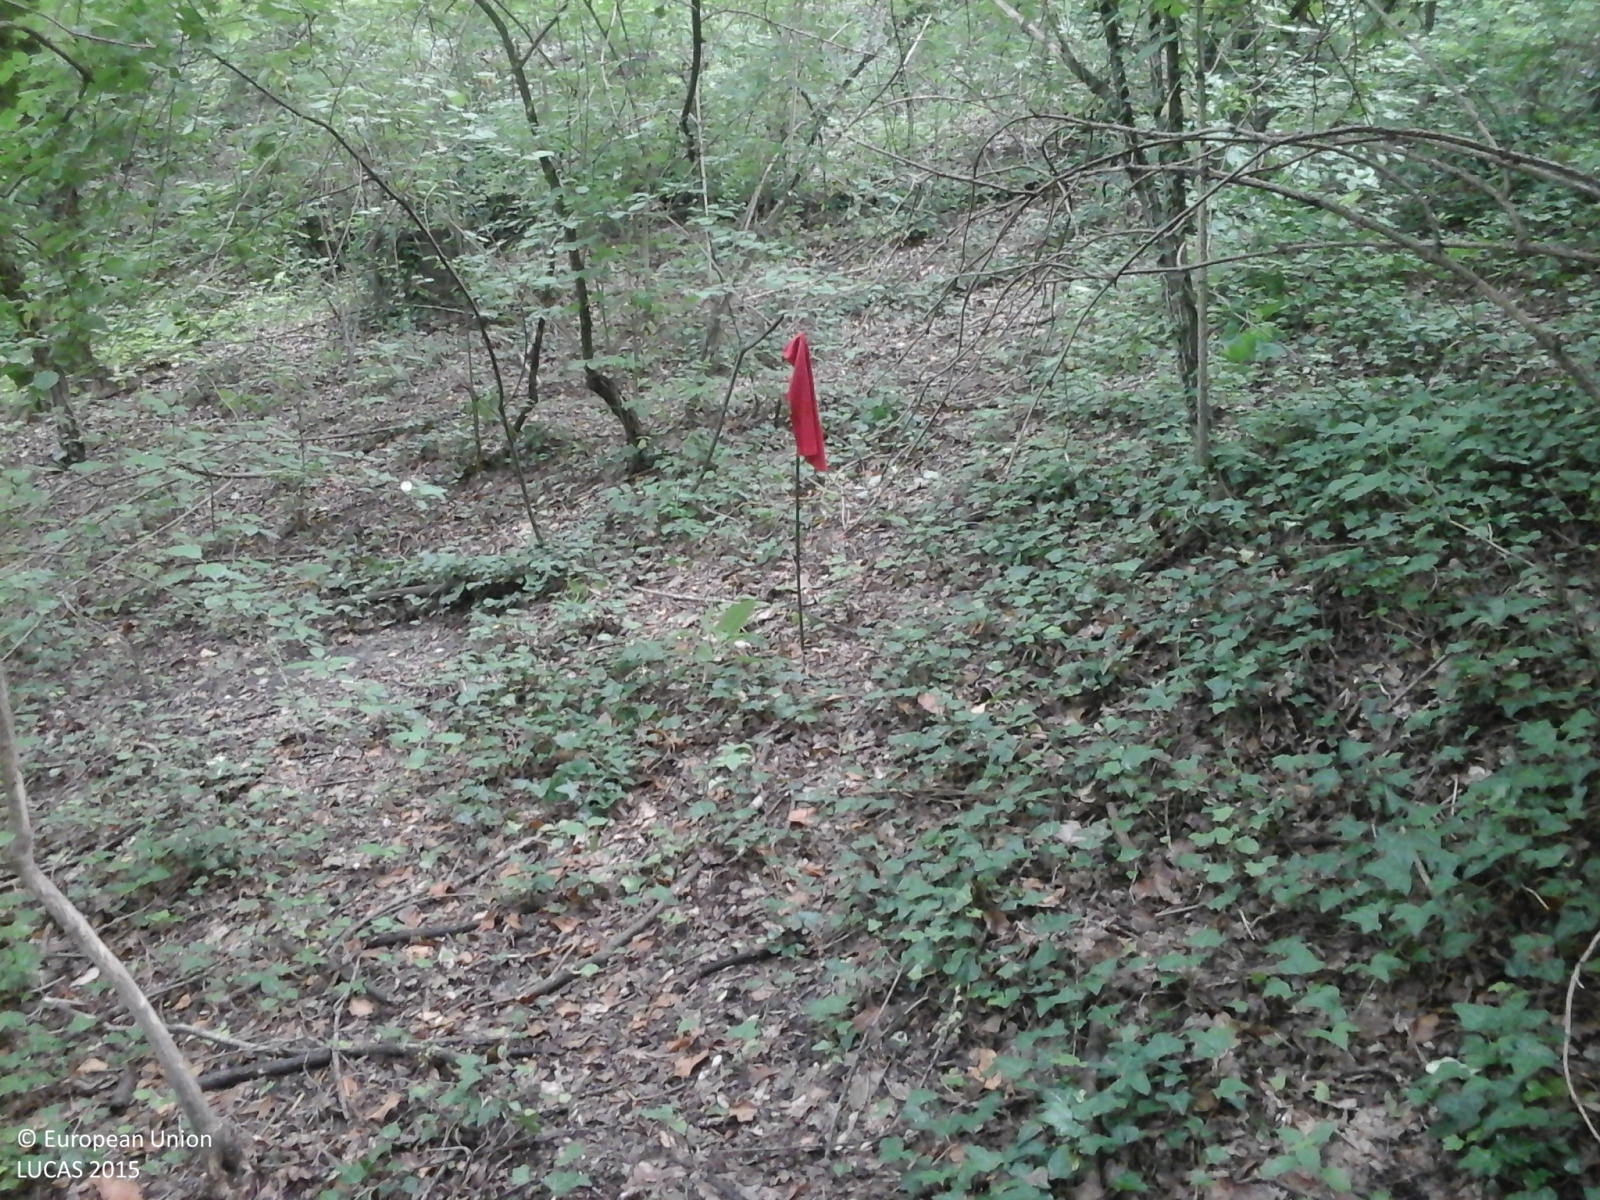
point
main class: Woodland
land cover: Broadleaved woodland
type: thermophilous deciduous forest
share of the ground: > 75 %
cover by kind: broadleaved forest trees 100 %
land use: Forestry
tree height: > 5 m
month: June
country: IT
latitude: 45.1480
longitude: 8.2861
